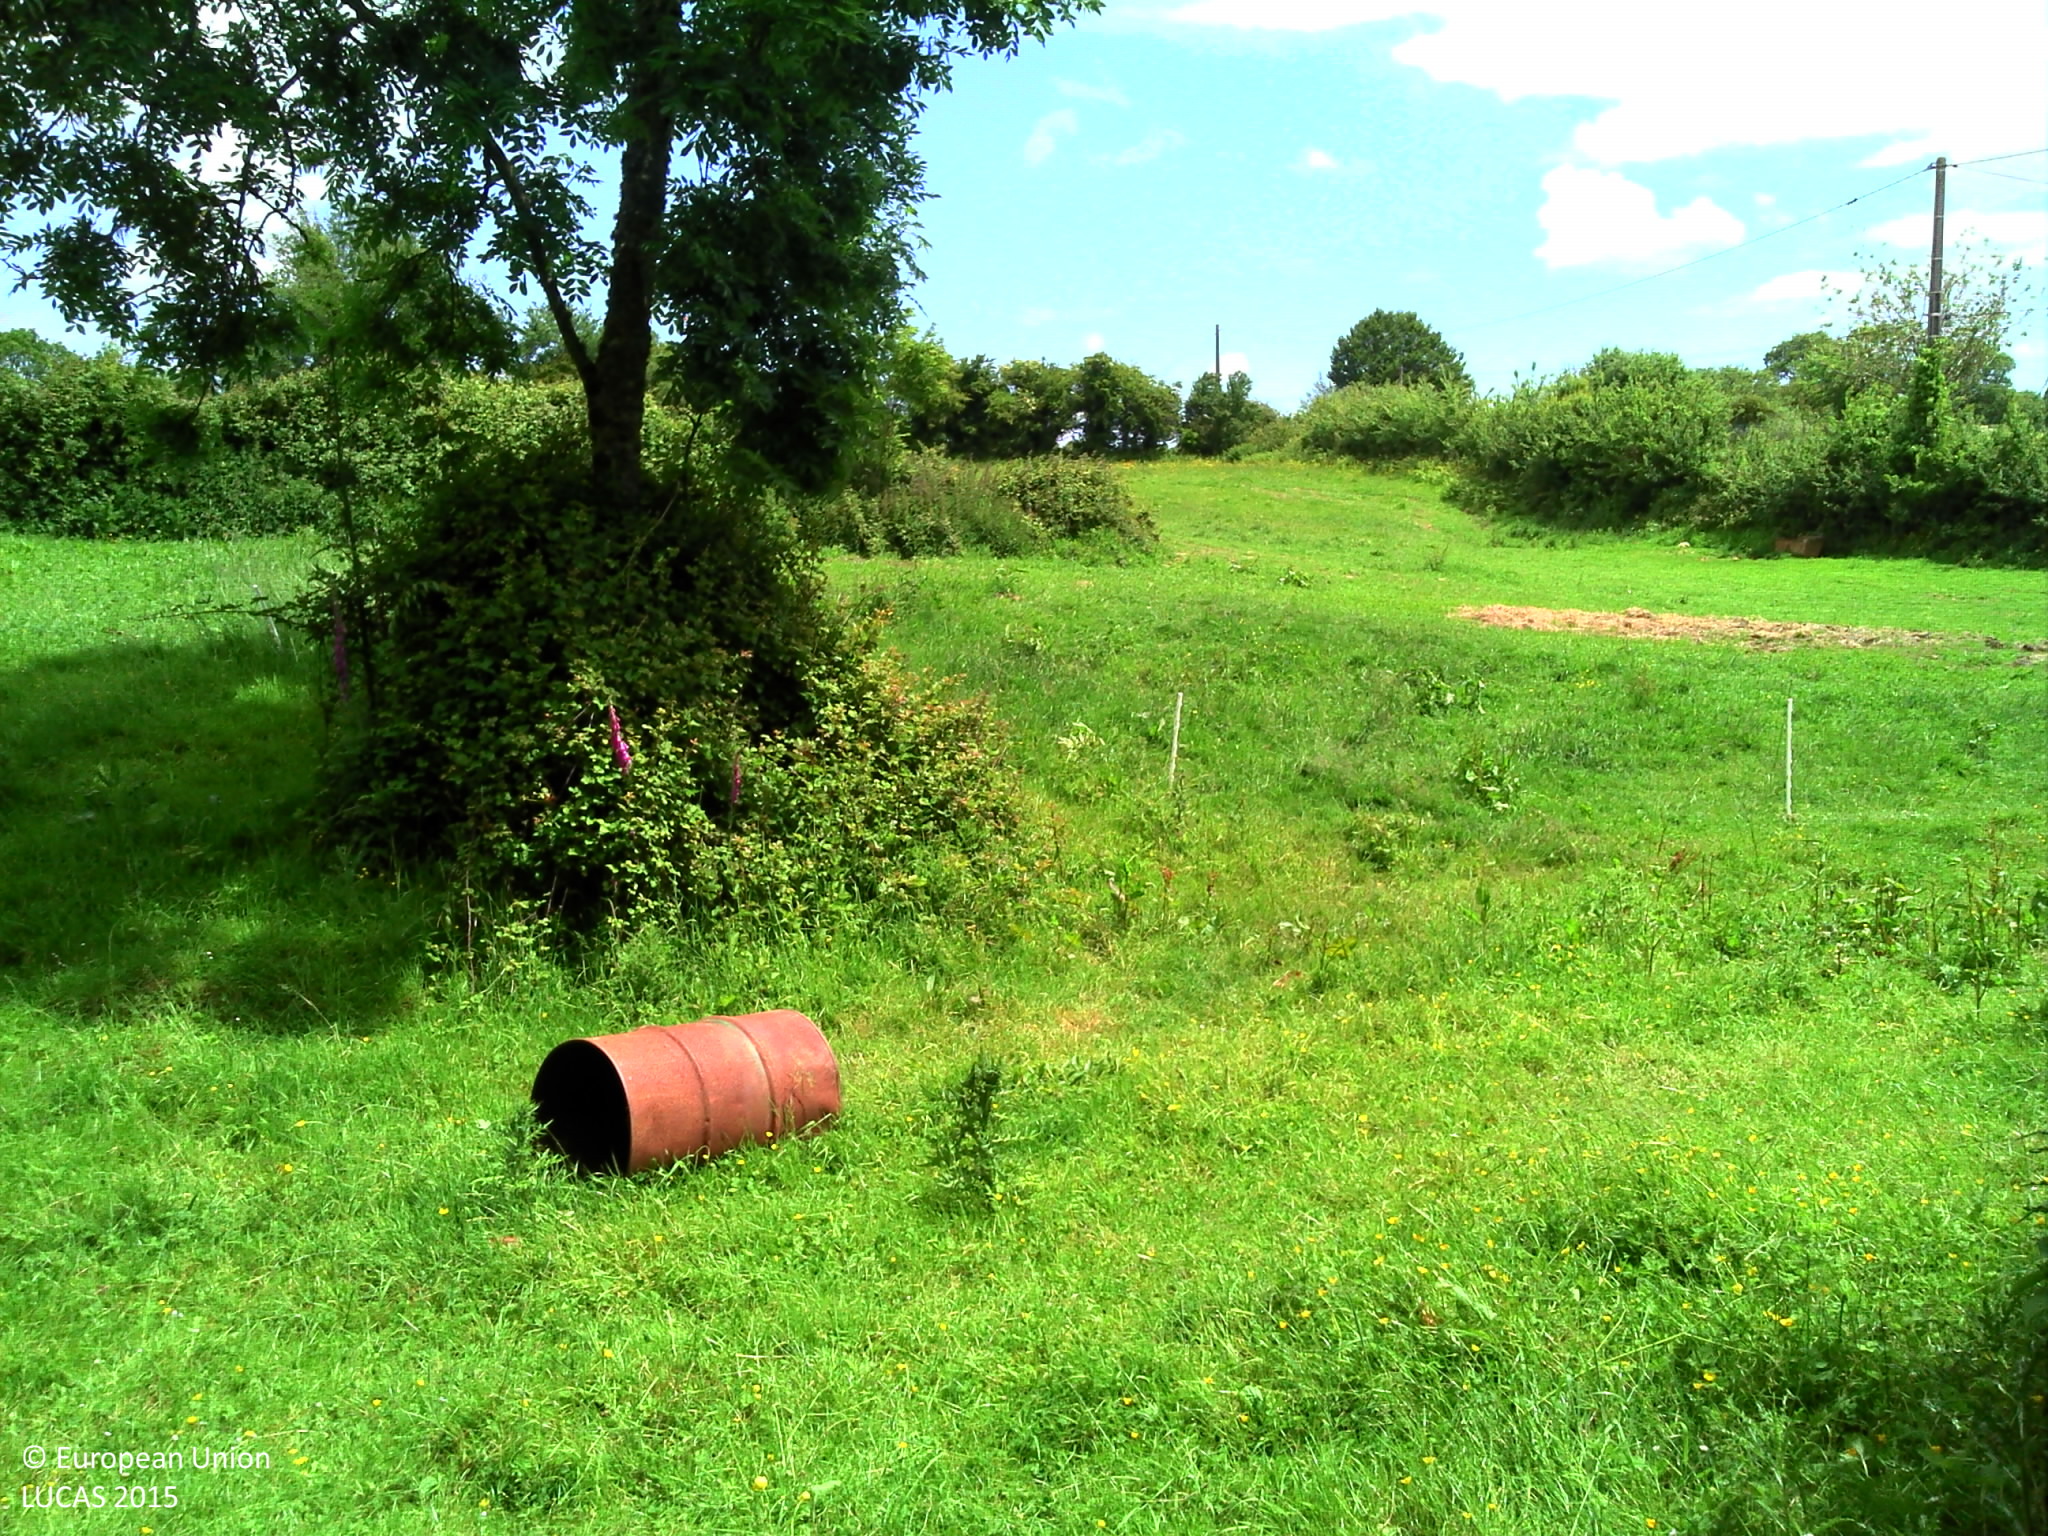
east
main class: Woodland
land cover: Broadleaved woodland
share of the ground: > 75 %
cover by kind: broadleaved forest trees 90 %, shrubs 5 %, herbaceous plants 5 %
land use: Residential
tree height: > 5 m
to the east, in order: Broadleaved woodland; Grassland with sparse tree/shrub cover; Managed hedges; Grassland without tree/shrub cover; Abandoned hedges; Common wheat; Abandoned hedges; Grass margins; Tracks; Grass margins; Electric lines; Managed hedges; Artificial constructions in urban areas; Ditches and canals; Grass margins; Paved roads, cycling and walking lanes; Grass margins; Abandoned hedges; Grassland without tree/shrub cover; Abandoned hedges
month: June
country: FR
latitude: 49.5832
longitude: -1.4881
